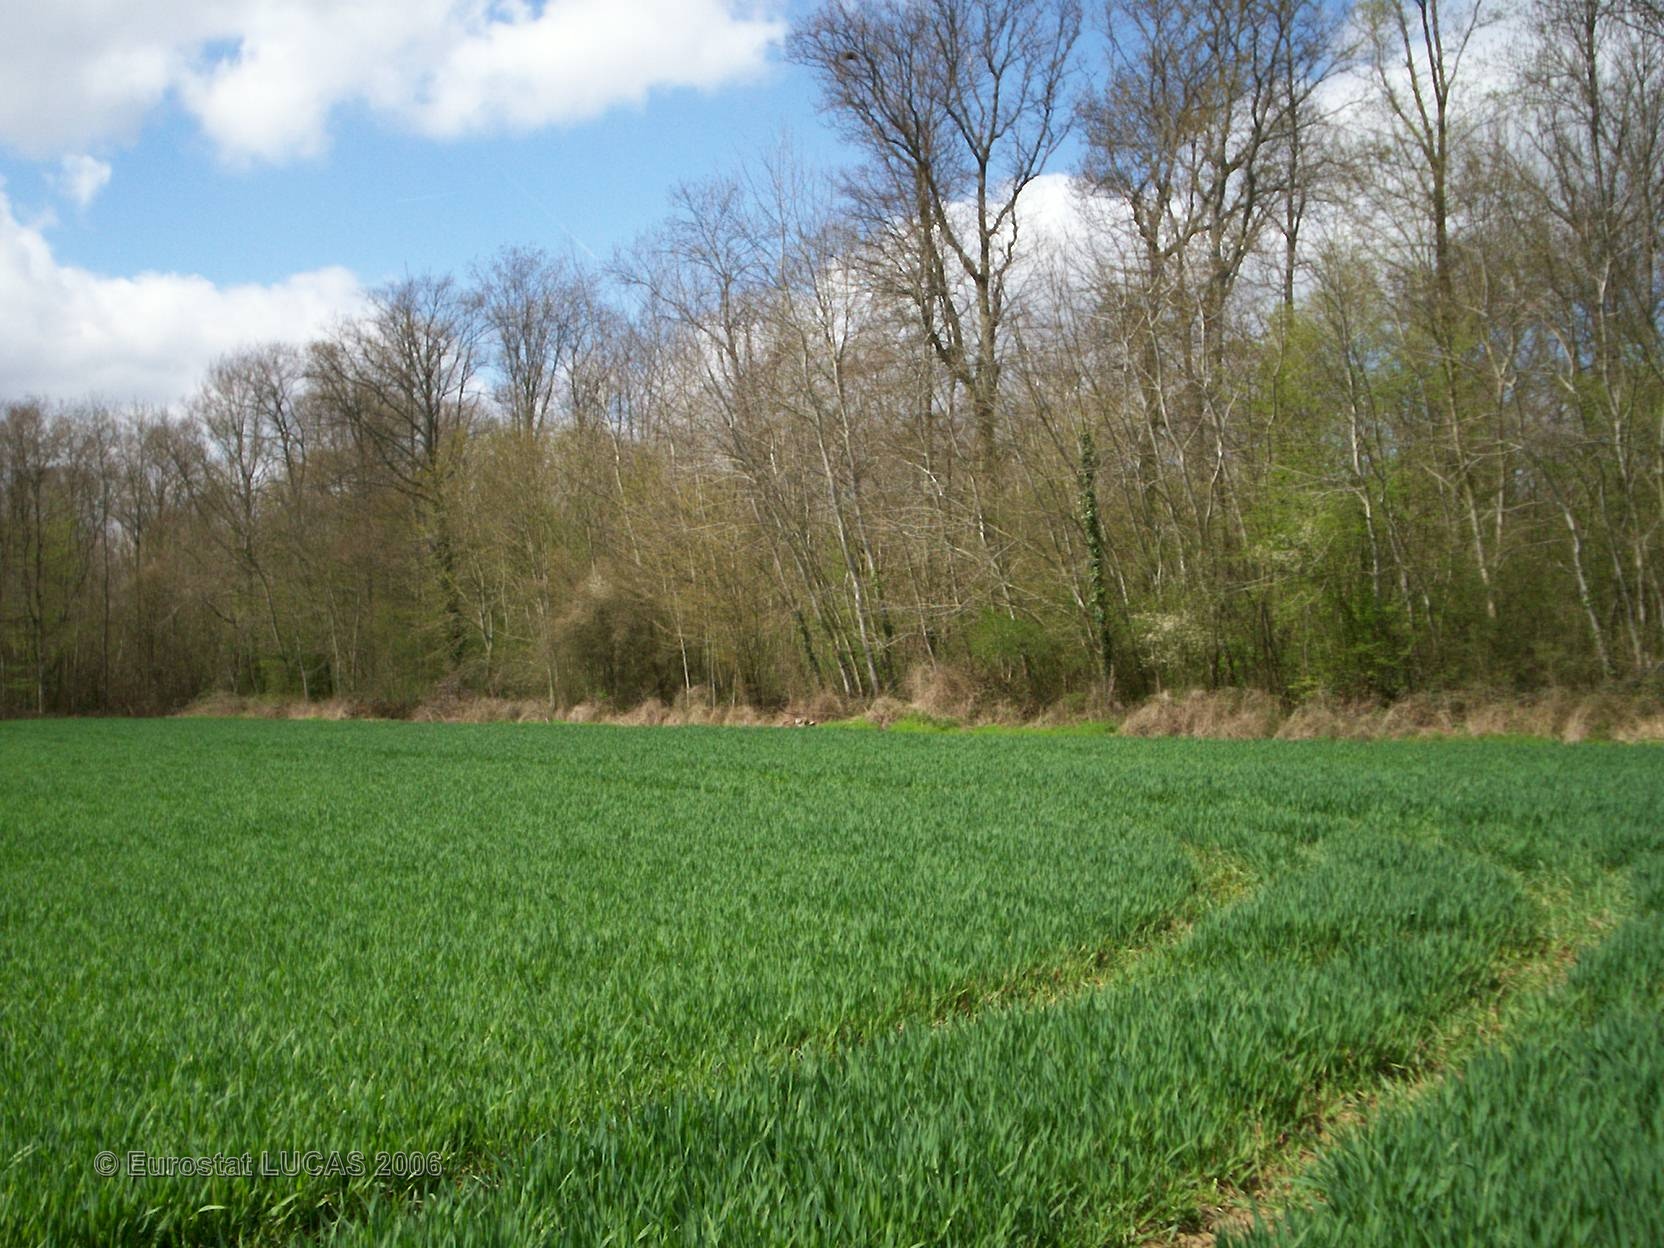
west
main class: Cropland
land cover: Common wheat
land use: Agriculture (excluding fallow land and kitchen gardens)
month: April
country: FR
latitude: 48.5334
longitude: 2.8542
